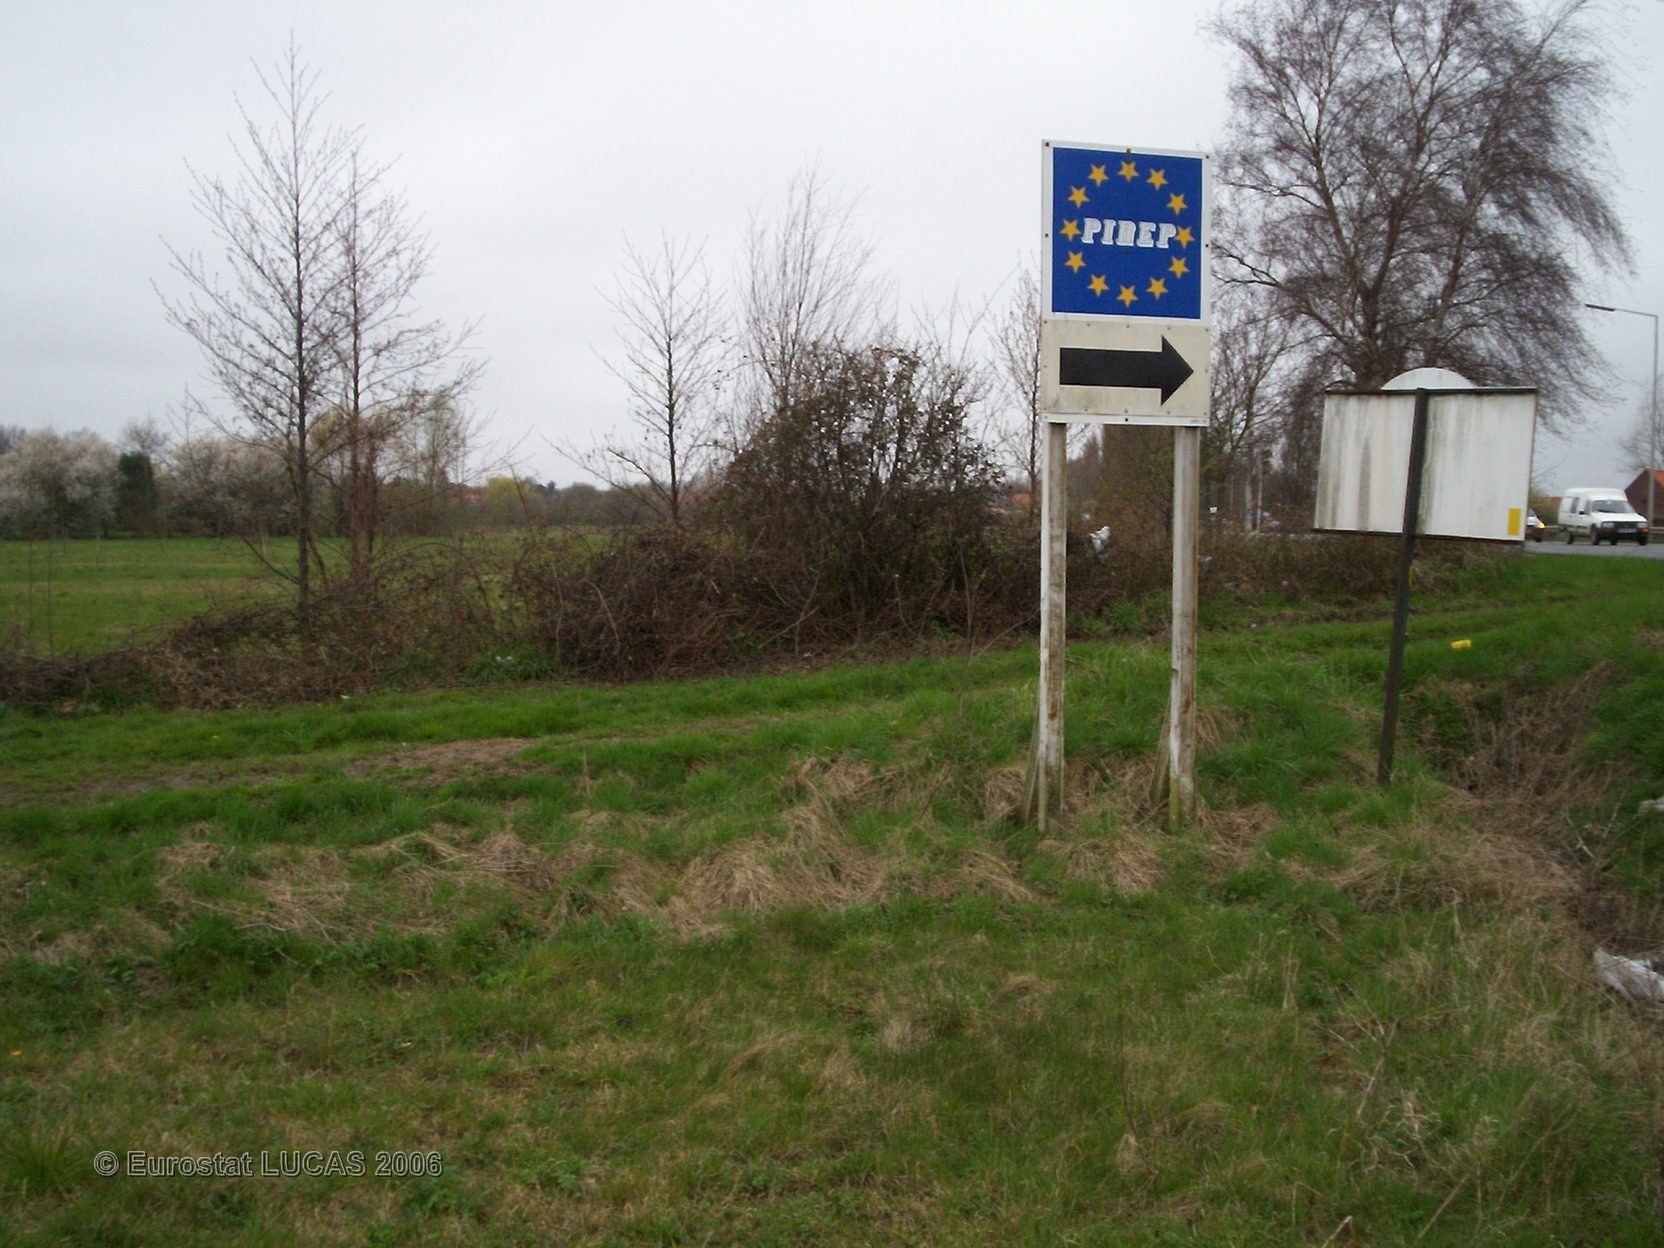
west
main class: Grassland
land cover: Grassland without tree/shrub cover
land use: Agriculture (excluding fallow land and kitchen gardens)
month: April
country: FR
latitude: 50.5685
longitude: 2.4902
